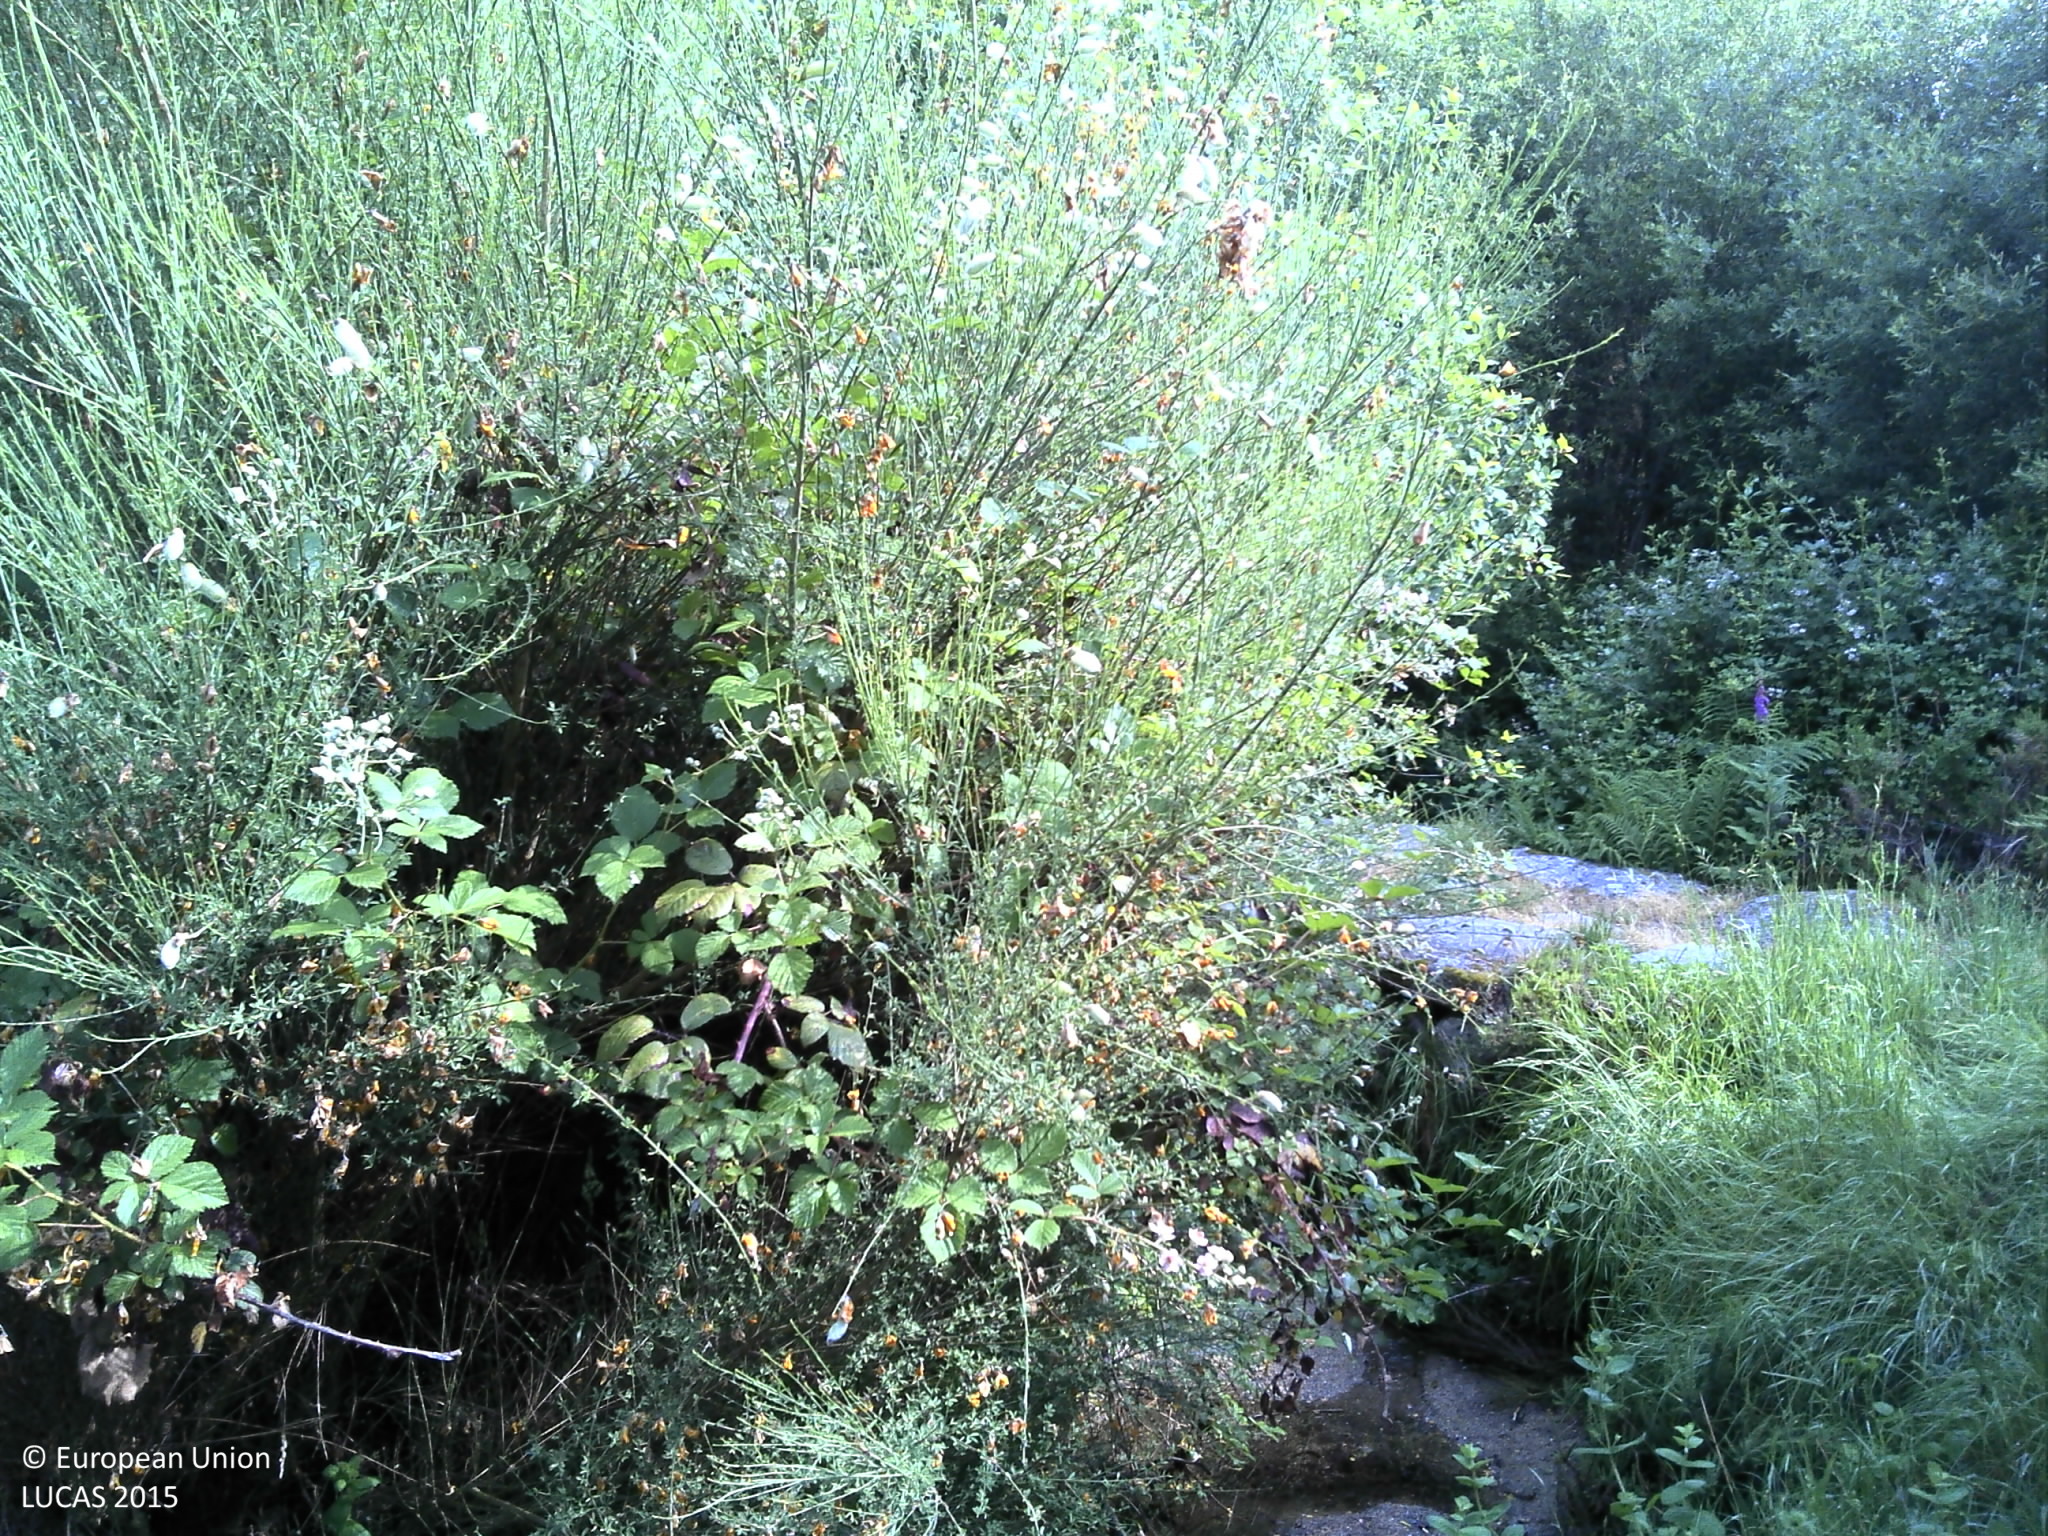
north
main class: Shrubland
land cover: Shrubland with sparse tree cover
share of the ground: > 75 %
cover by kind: shrubs 85 %, herbaceous plants 10 %, broadleaved forest trees 5 %
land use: Semi-natural and natural areas not in use
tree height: > 5 m
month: June
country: PT
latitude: 41.4275
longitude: -7.5132
